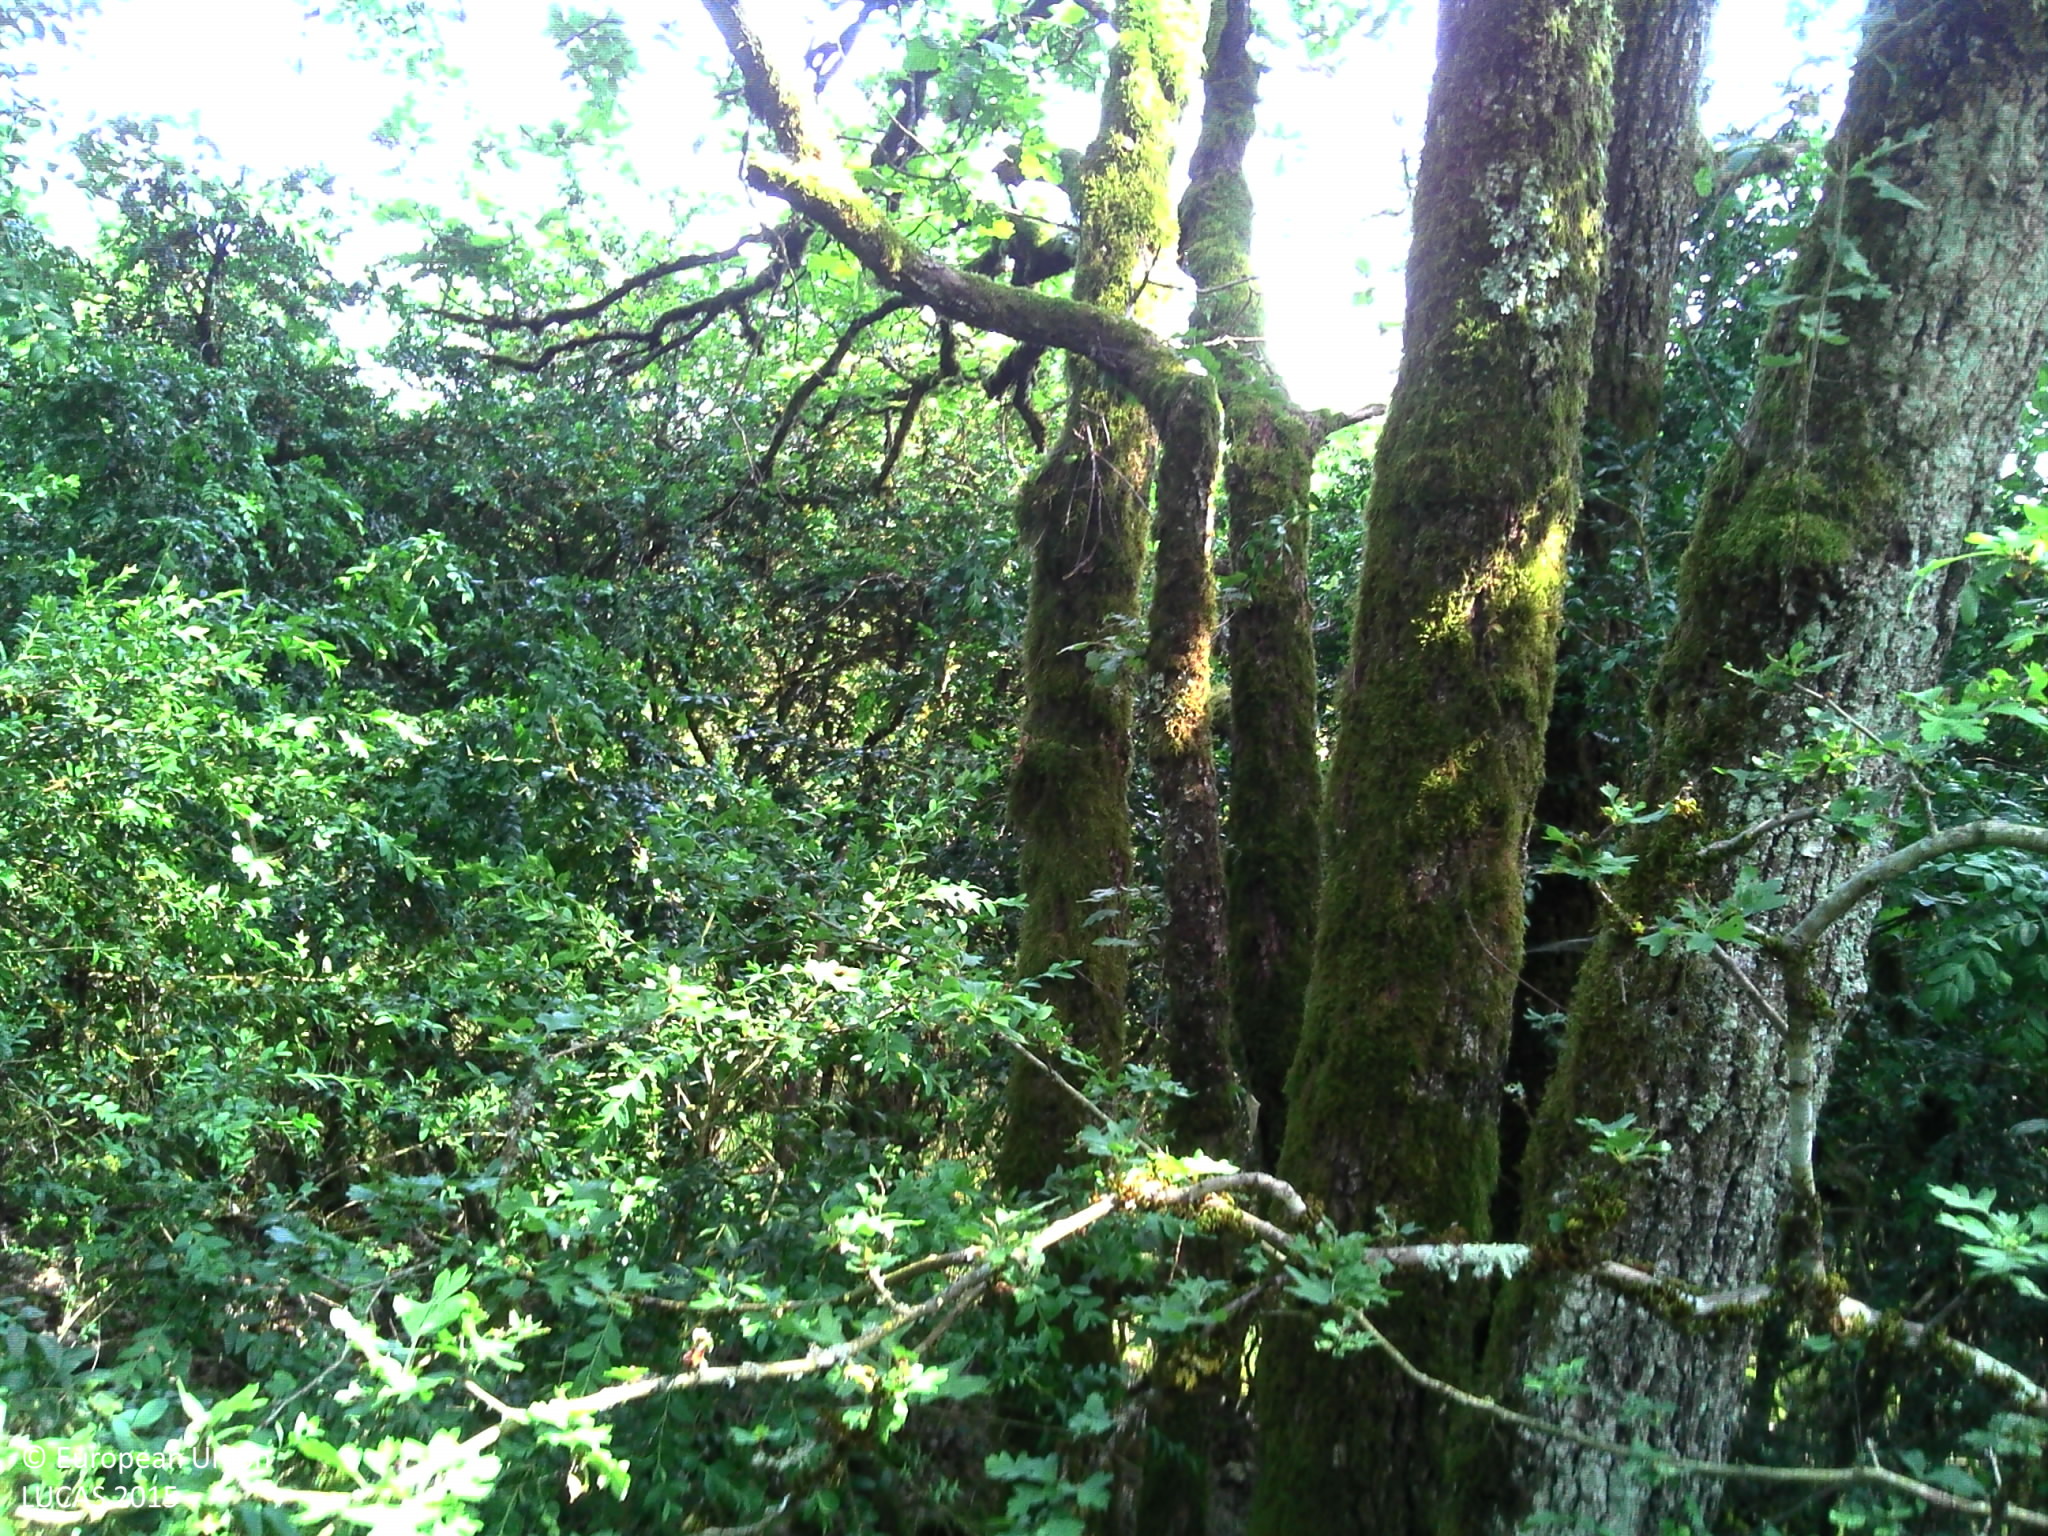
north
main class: Woodland
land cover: Pine dominated mixed woodland
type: hemiboreal forest and nemoral coniferous forest and mixed broadleaved-coniferous forest
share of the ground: > 75 %
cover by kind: coniferous forest trees 50 %, broadleaved forest trees 25 %, shrubs 10 %, lichens and mosses 10 %, herbaceous plants 5 %
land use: Forestry
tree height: > 5 m
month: June
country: FR
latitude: 47.0561
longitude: 4.8269
